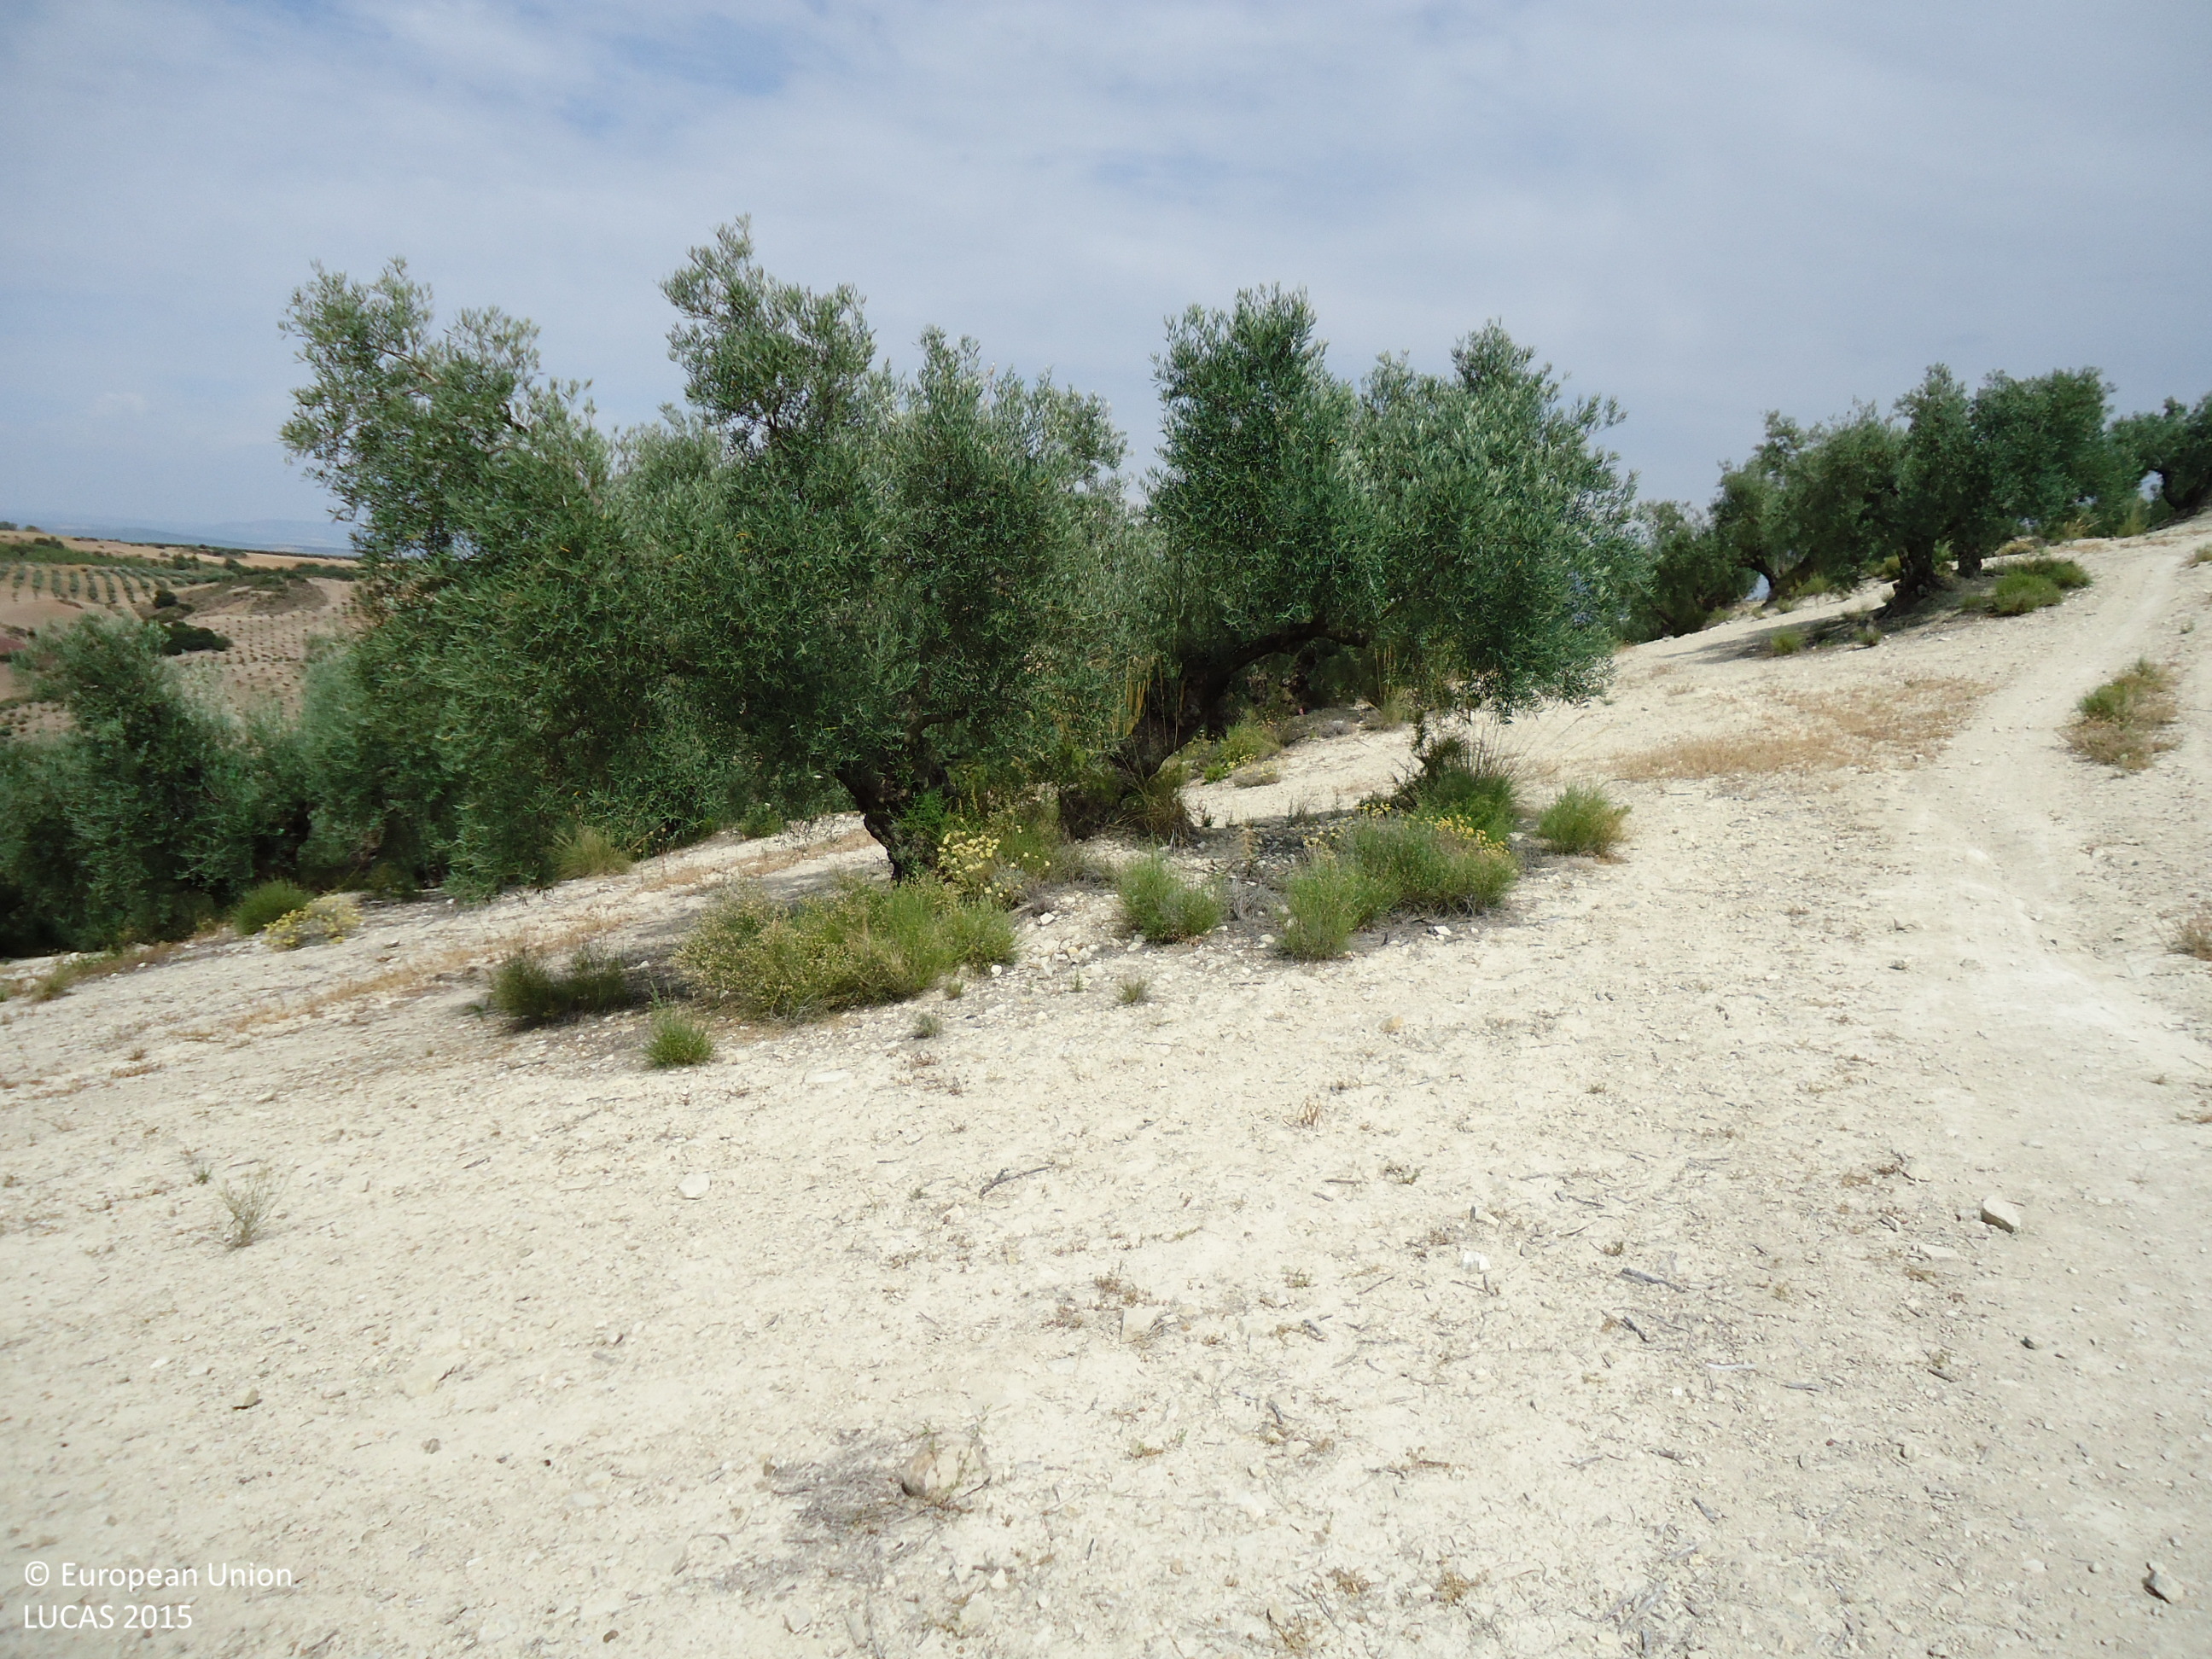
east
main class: Cropland
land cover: Olive groves
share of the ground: 25 - 50 %
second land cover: Other bare soil
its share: > 75 %
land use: Agriculture (excluding fallow land and kitchen gardens)
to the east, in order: Olive groves; Other bare soil
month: June
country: ES
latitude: 36.9845
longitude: -4.8178
